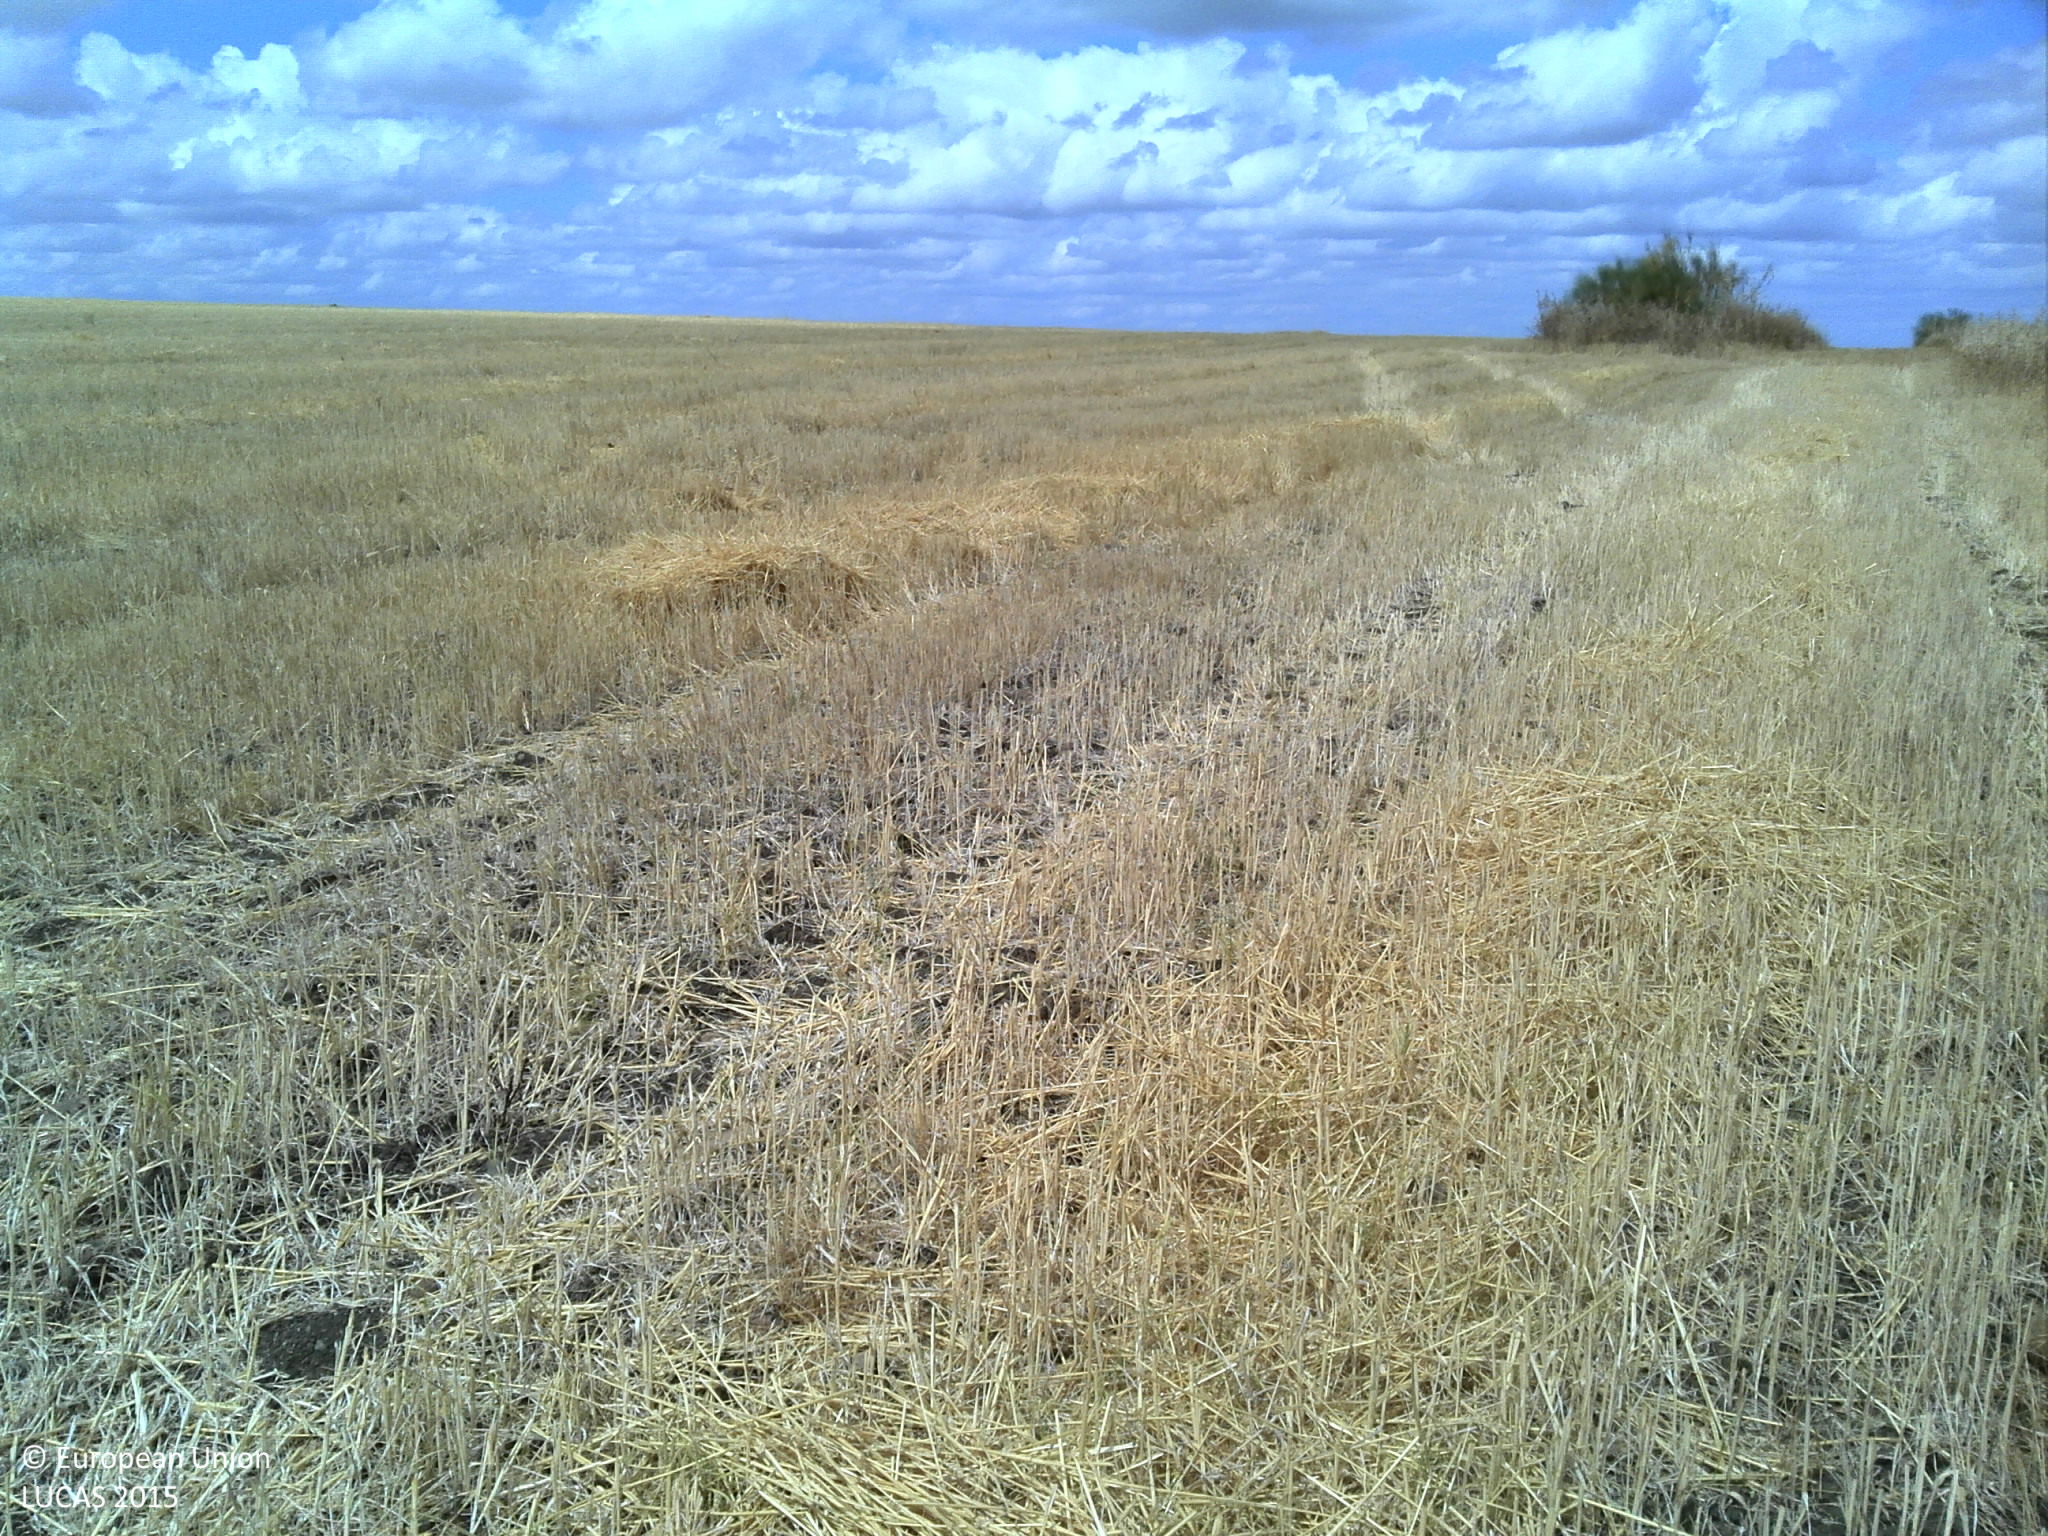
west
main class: Cropland
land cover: Common wheat
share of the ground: > 75 %
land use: Agriculture (excluding fallow land and kitchen gardens)
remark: Harvested field
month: July
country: PT
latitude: 38.1049
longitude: -7.7140
